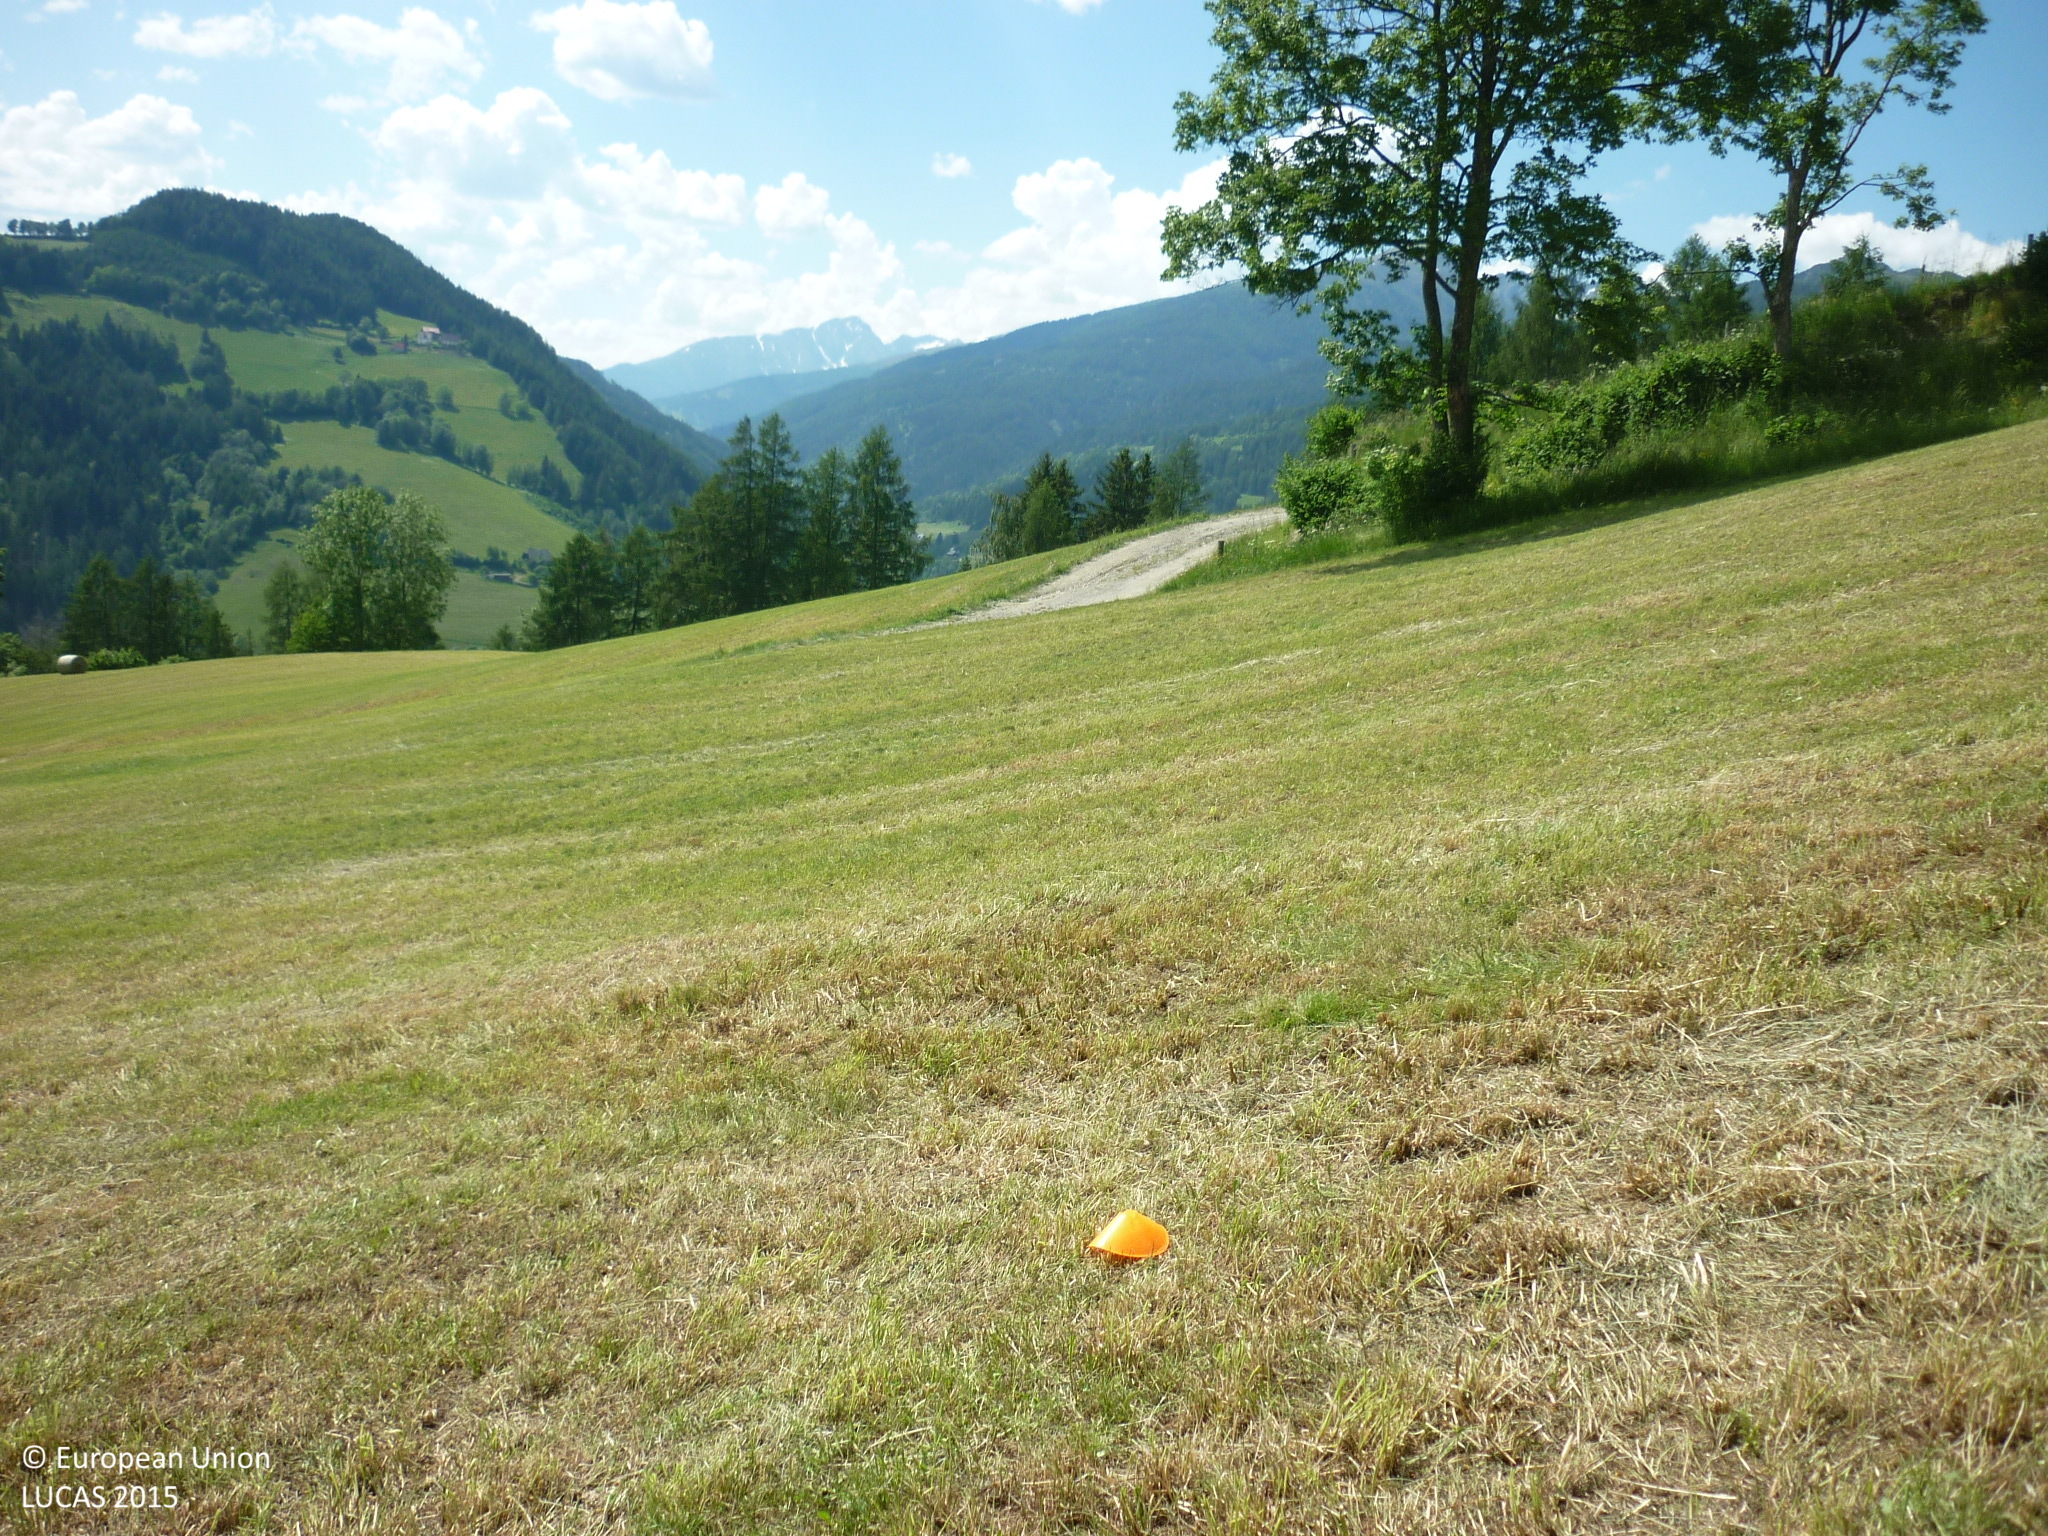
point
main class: Grassland
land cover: Grassland without tree/shrub cover
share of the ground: > 75 %
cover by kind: herbaceous plants 100 %
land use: Agriculture (excluding fallow land and kitchen gardens)
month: June
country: AT
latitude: 47.1731
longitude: 14.1279
